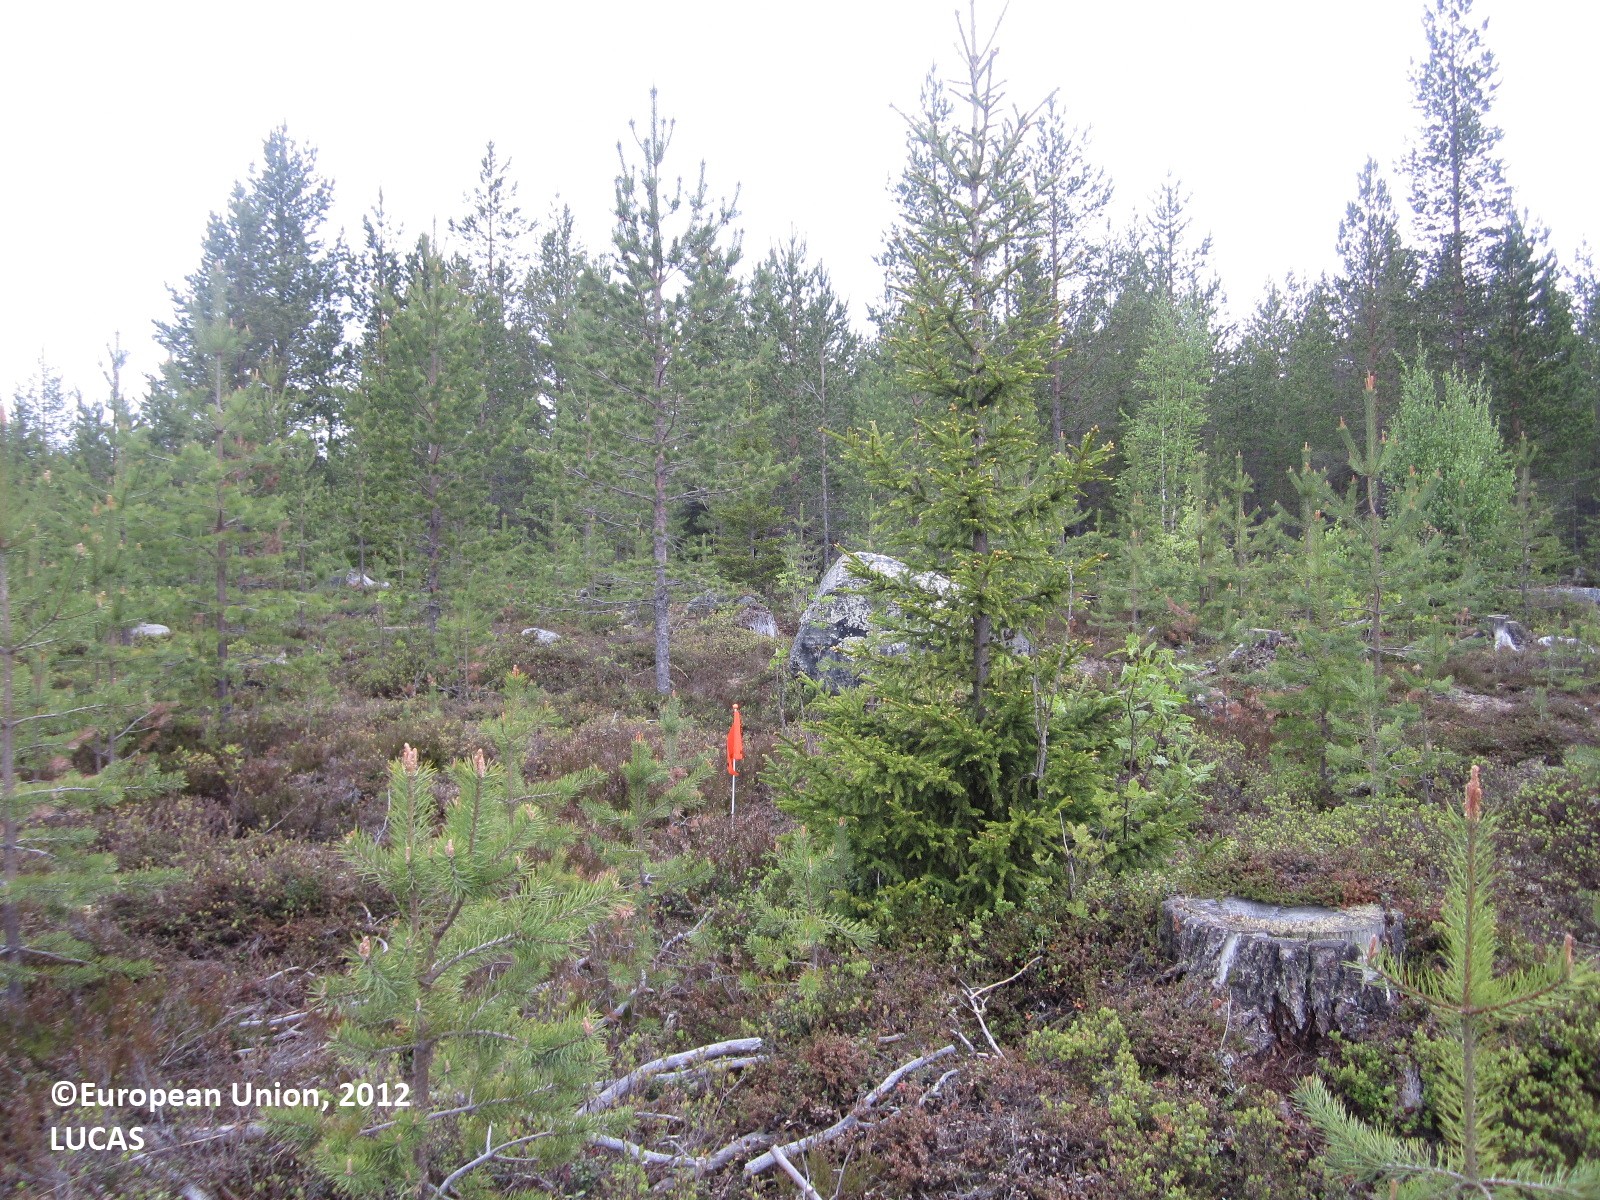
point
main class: Woodland
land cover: Pine dominated coniferous woodland
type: boreal forest
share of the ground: 10 - 25 %
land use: Forestry
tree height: < 5 m
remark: Clear cut
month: June
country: FI
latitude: 64.7459
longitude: 28.8610
